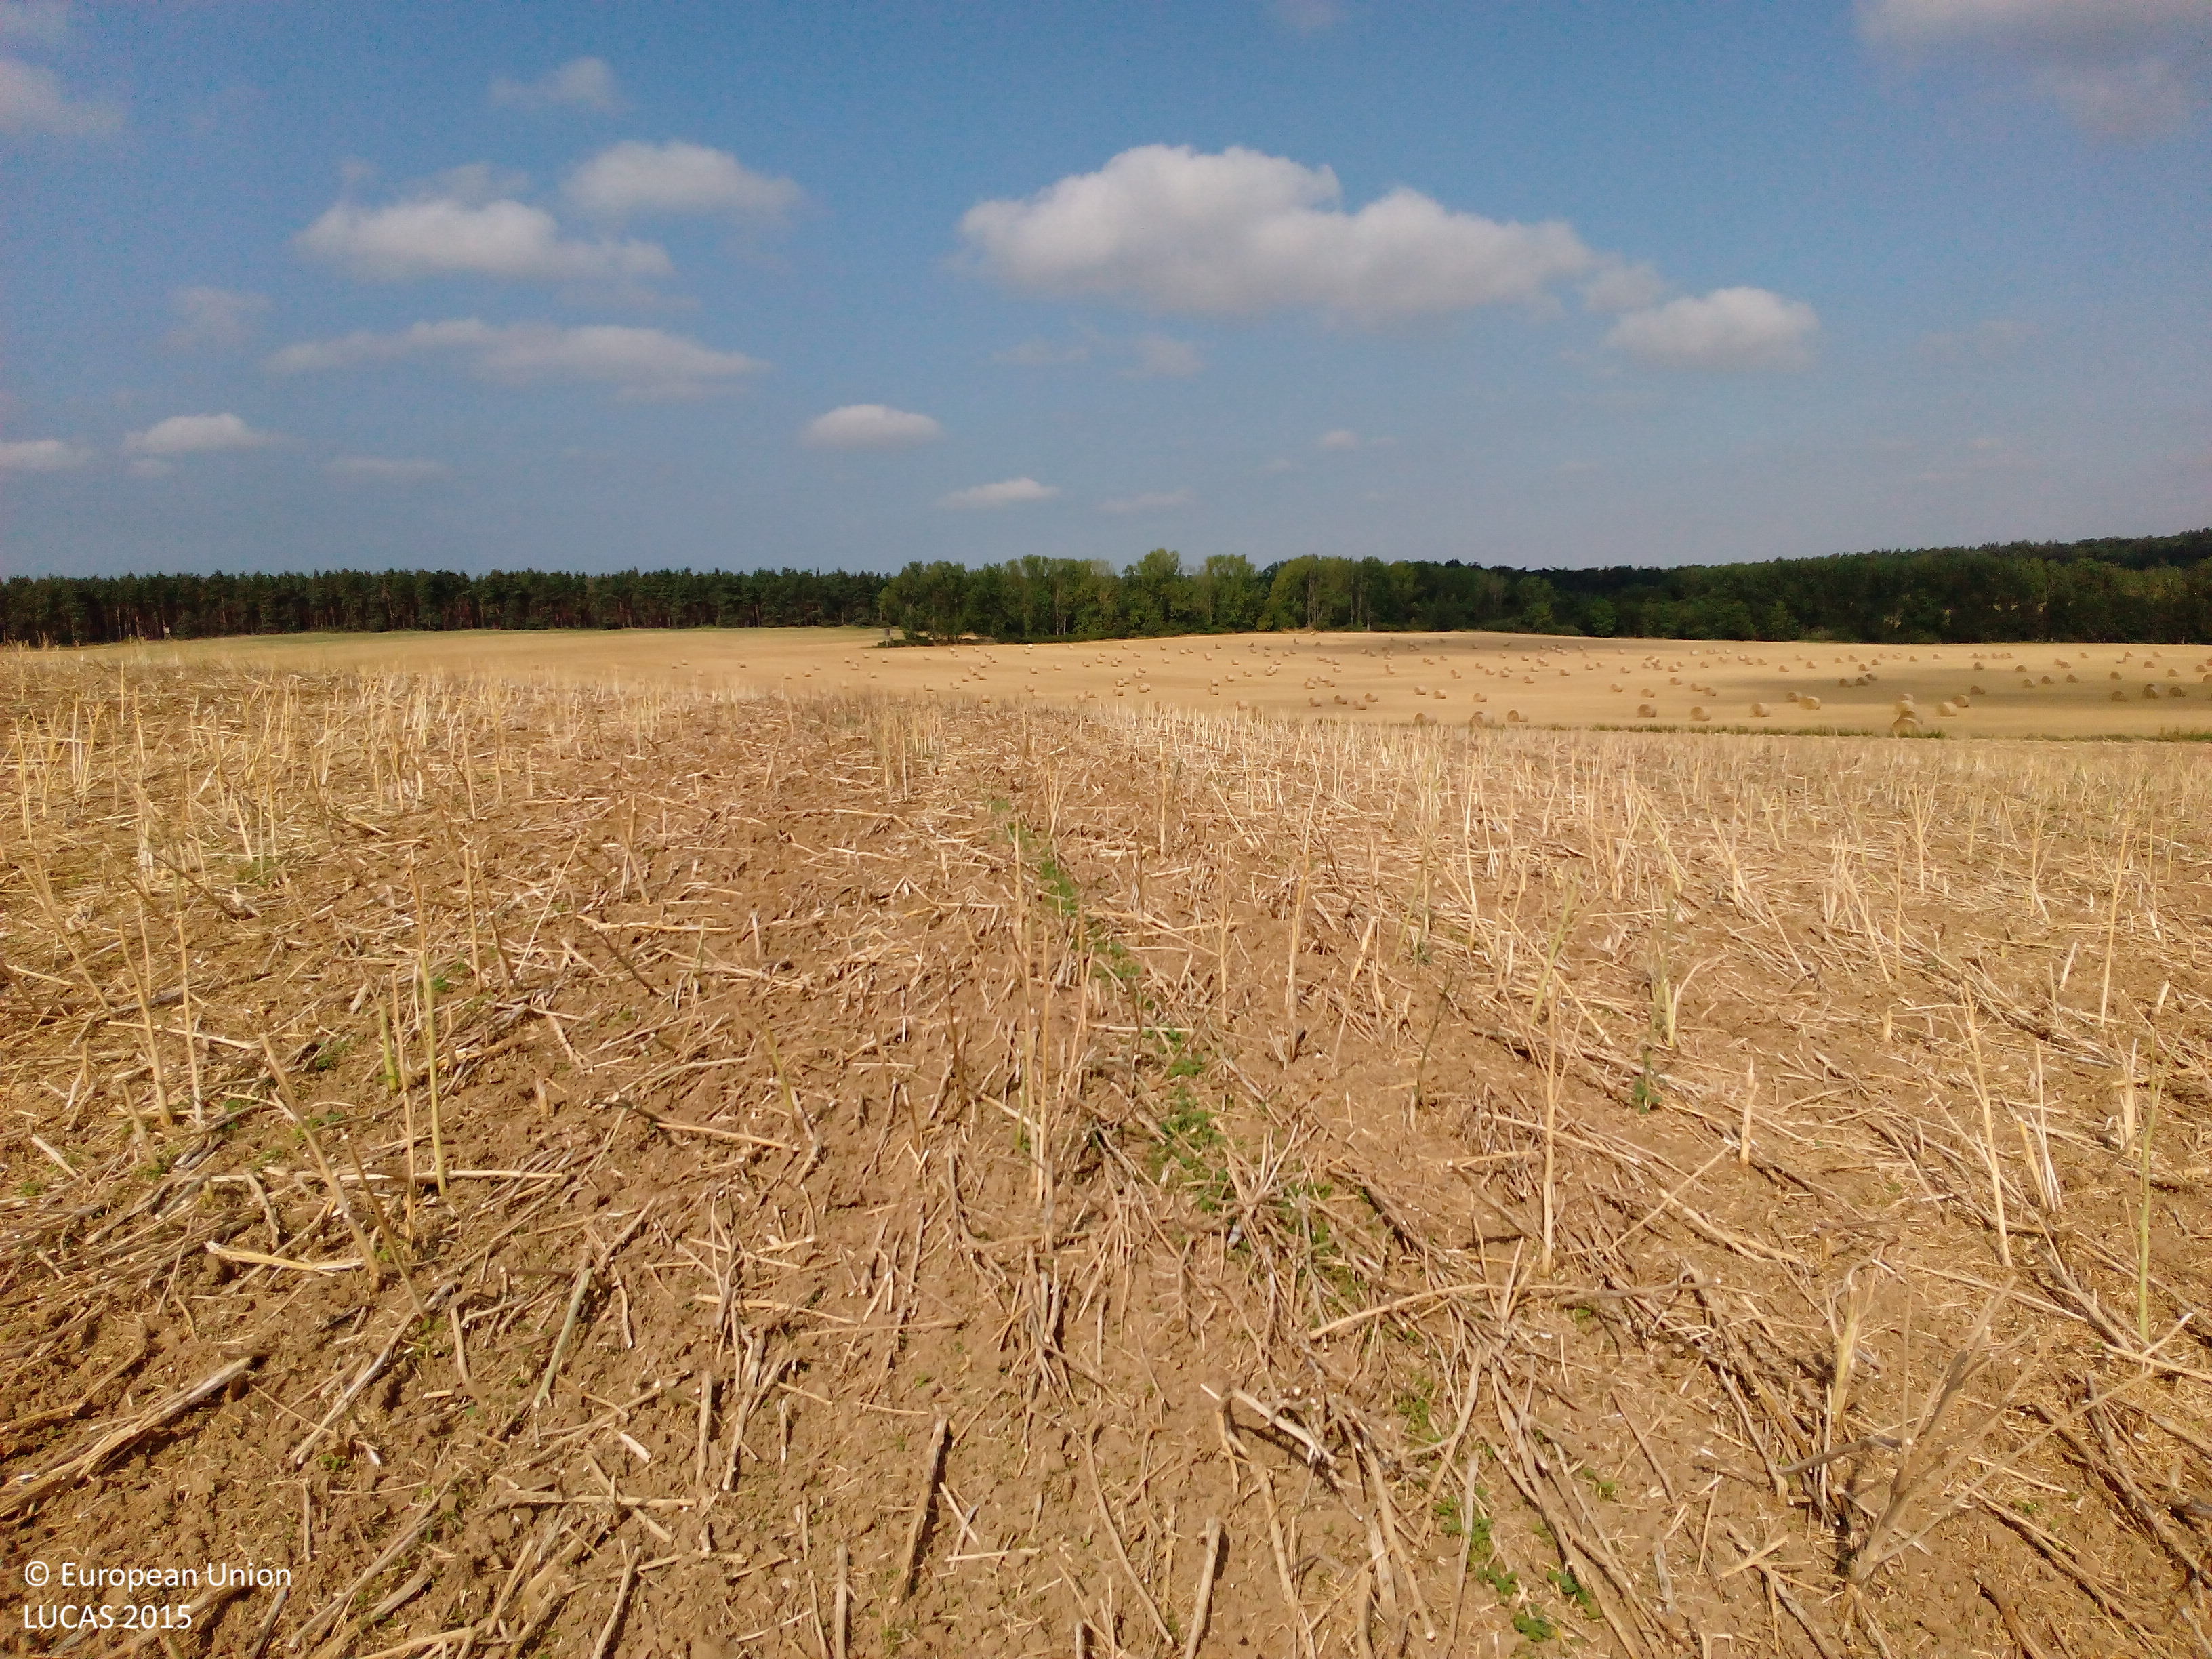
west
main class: Cropland
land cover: Rape and turnip rape
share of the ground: 10 - 25 %
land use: Agriculture (excluding fallow land and kitchen gardens)
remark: Harvested field
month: August
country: DE
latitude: 51.8342
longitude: 10.9720
